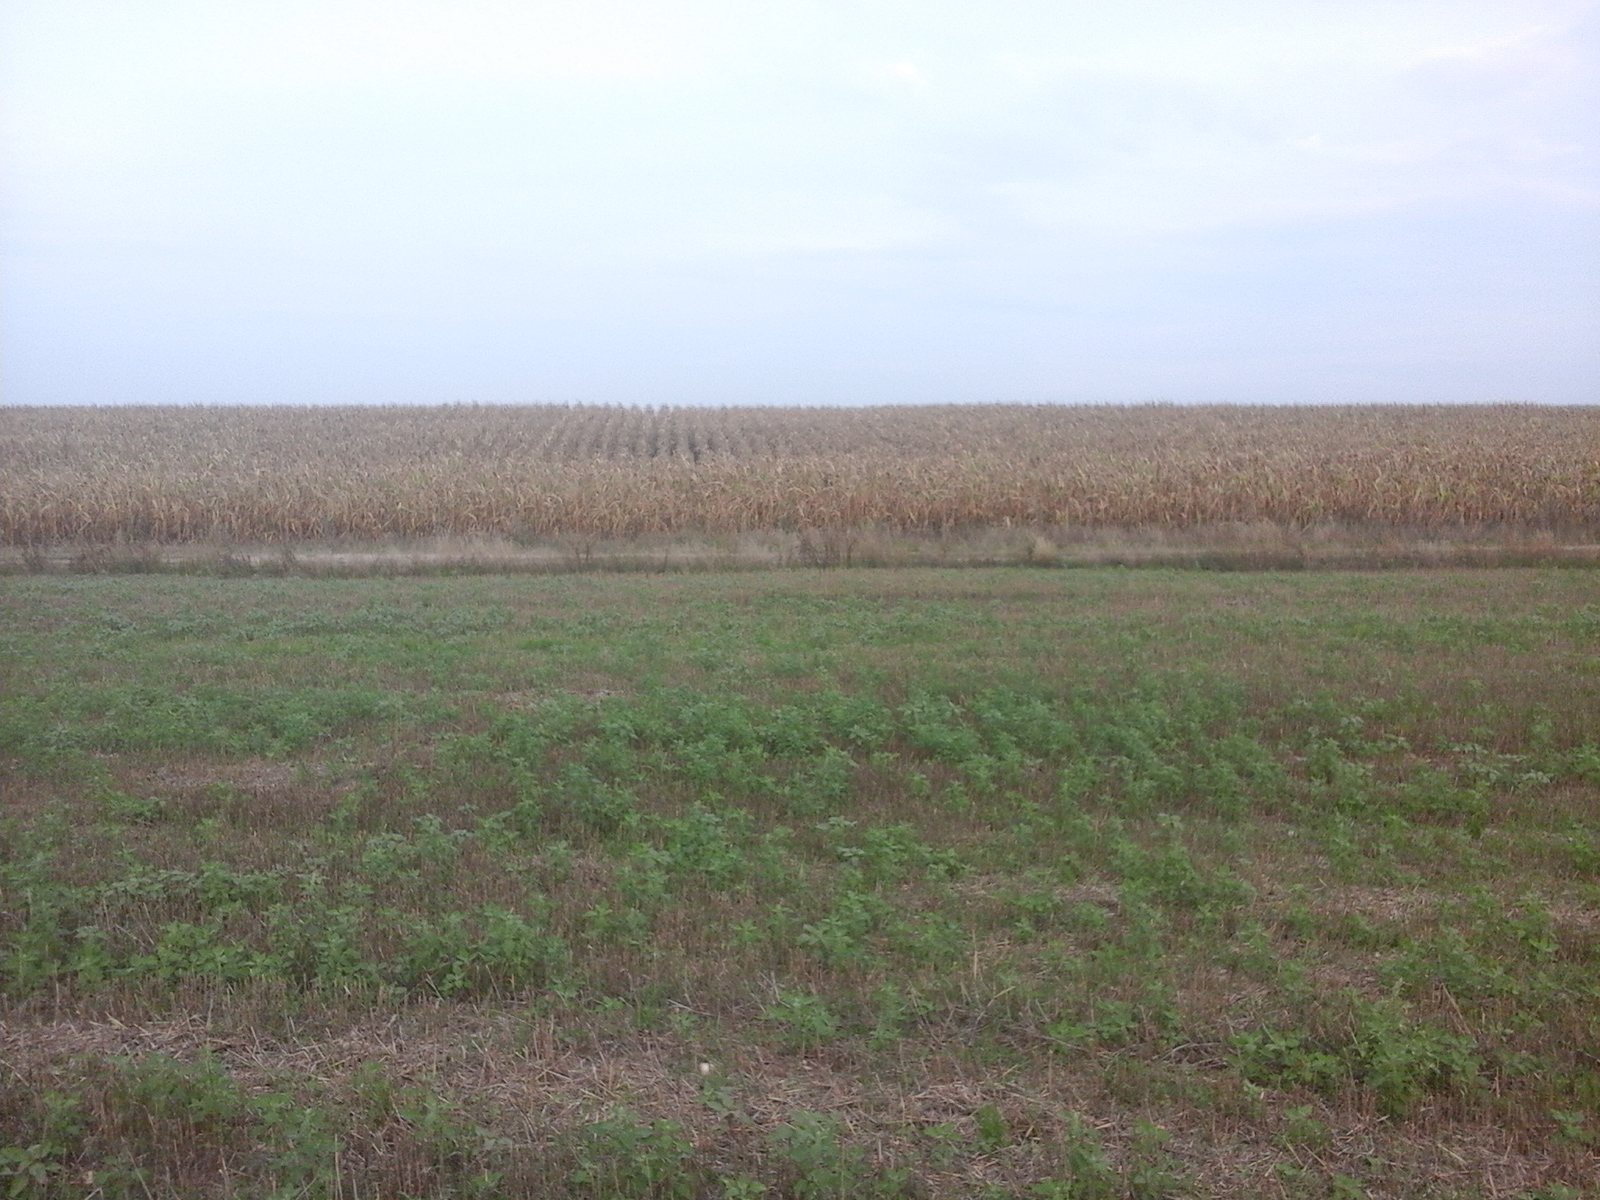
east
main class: Cropland
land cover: Common wheat
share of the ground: < 10 %
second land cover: Spontaneously vegetated surfaces
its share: 50 - 75 %
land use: Agriculture (excluding fallow land and kitchen gardens)
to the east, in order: Common wheat; Spontaneously vegetated surfaces; Tracks; Grass margins; Maize
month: August
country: RO
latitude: 46.2365
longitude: 21.5130
